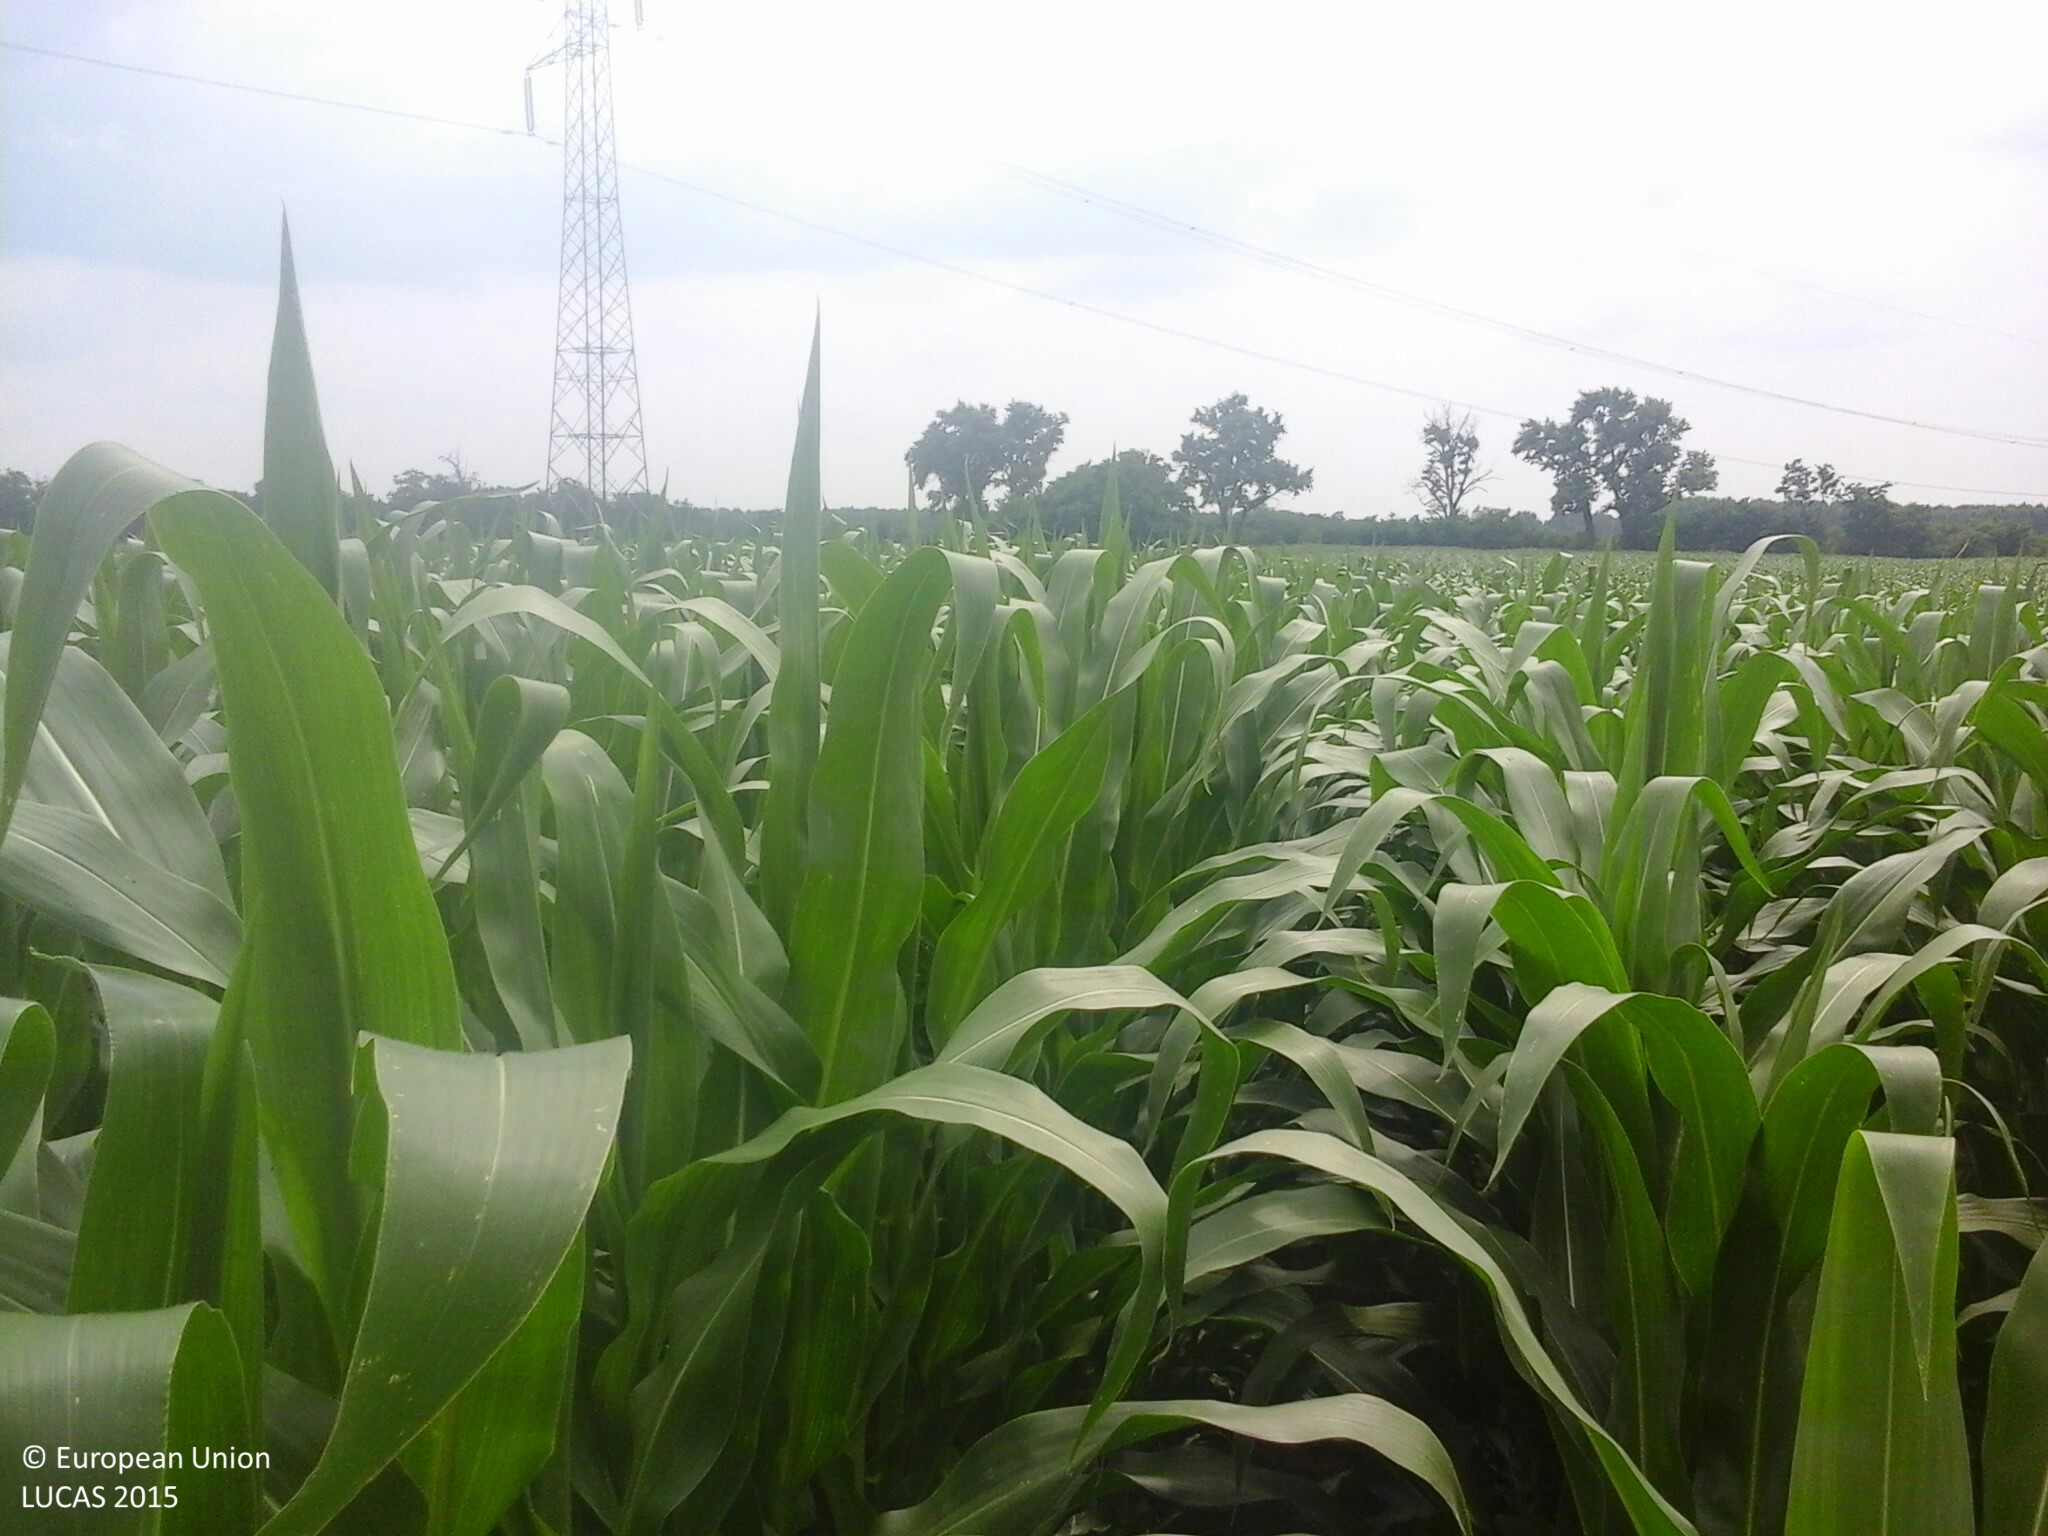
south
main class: Cropland
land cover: Maize
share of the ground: > 75 %
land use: Agriculture (excluding fallow land and kitchen gardens)
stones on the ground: < 10 %
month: June
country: HU
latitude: 47.3720
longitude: 19.3562
